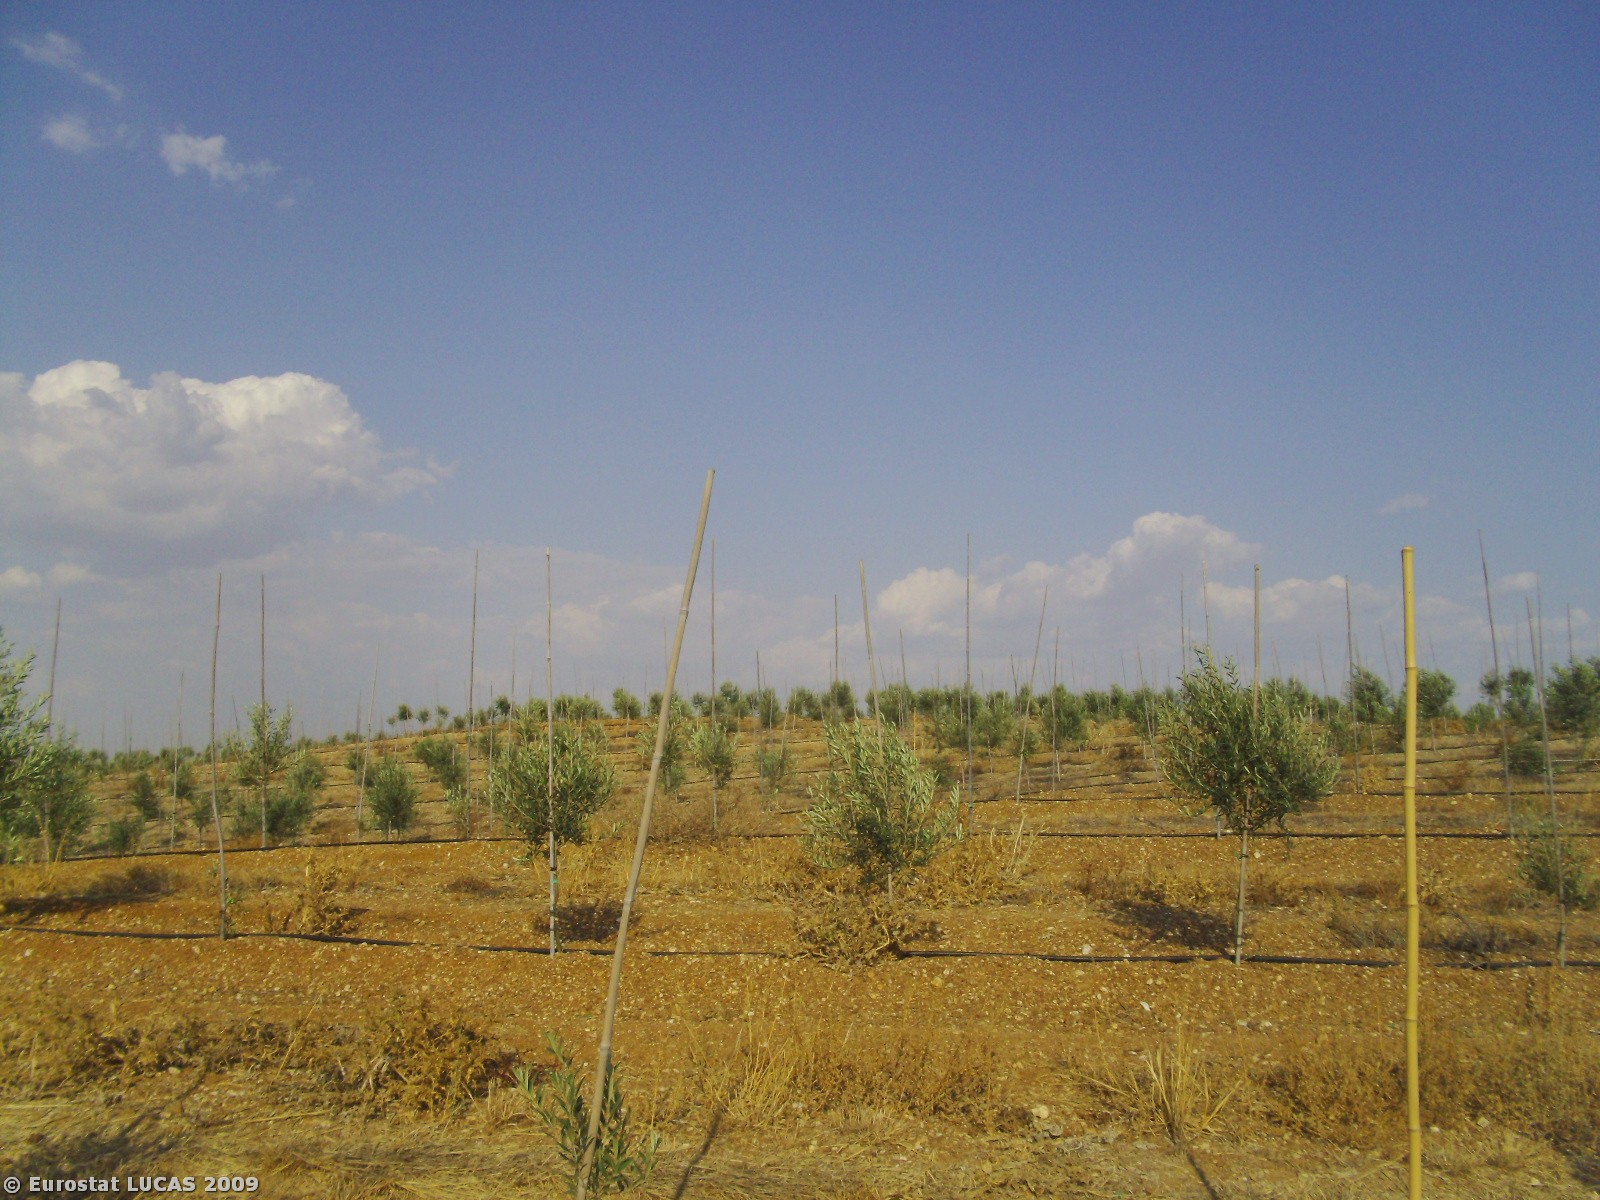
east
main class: Cropland
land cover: Olive groves
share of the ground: 50 - 75 %
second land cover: Spontaneously vegetated surfaces
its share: > 75 %
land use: Agriculture (excluding fallow land and kitchen gardens)
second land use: Fallow land
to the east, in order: Olive groves; Spontaneously vegetated surfaces; Olive groves; Bare land; Olive groves
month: August
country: PT
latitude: 37.8762
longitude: -8.3286
